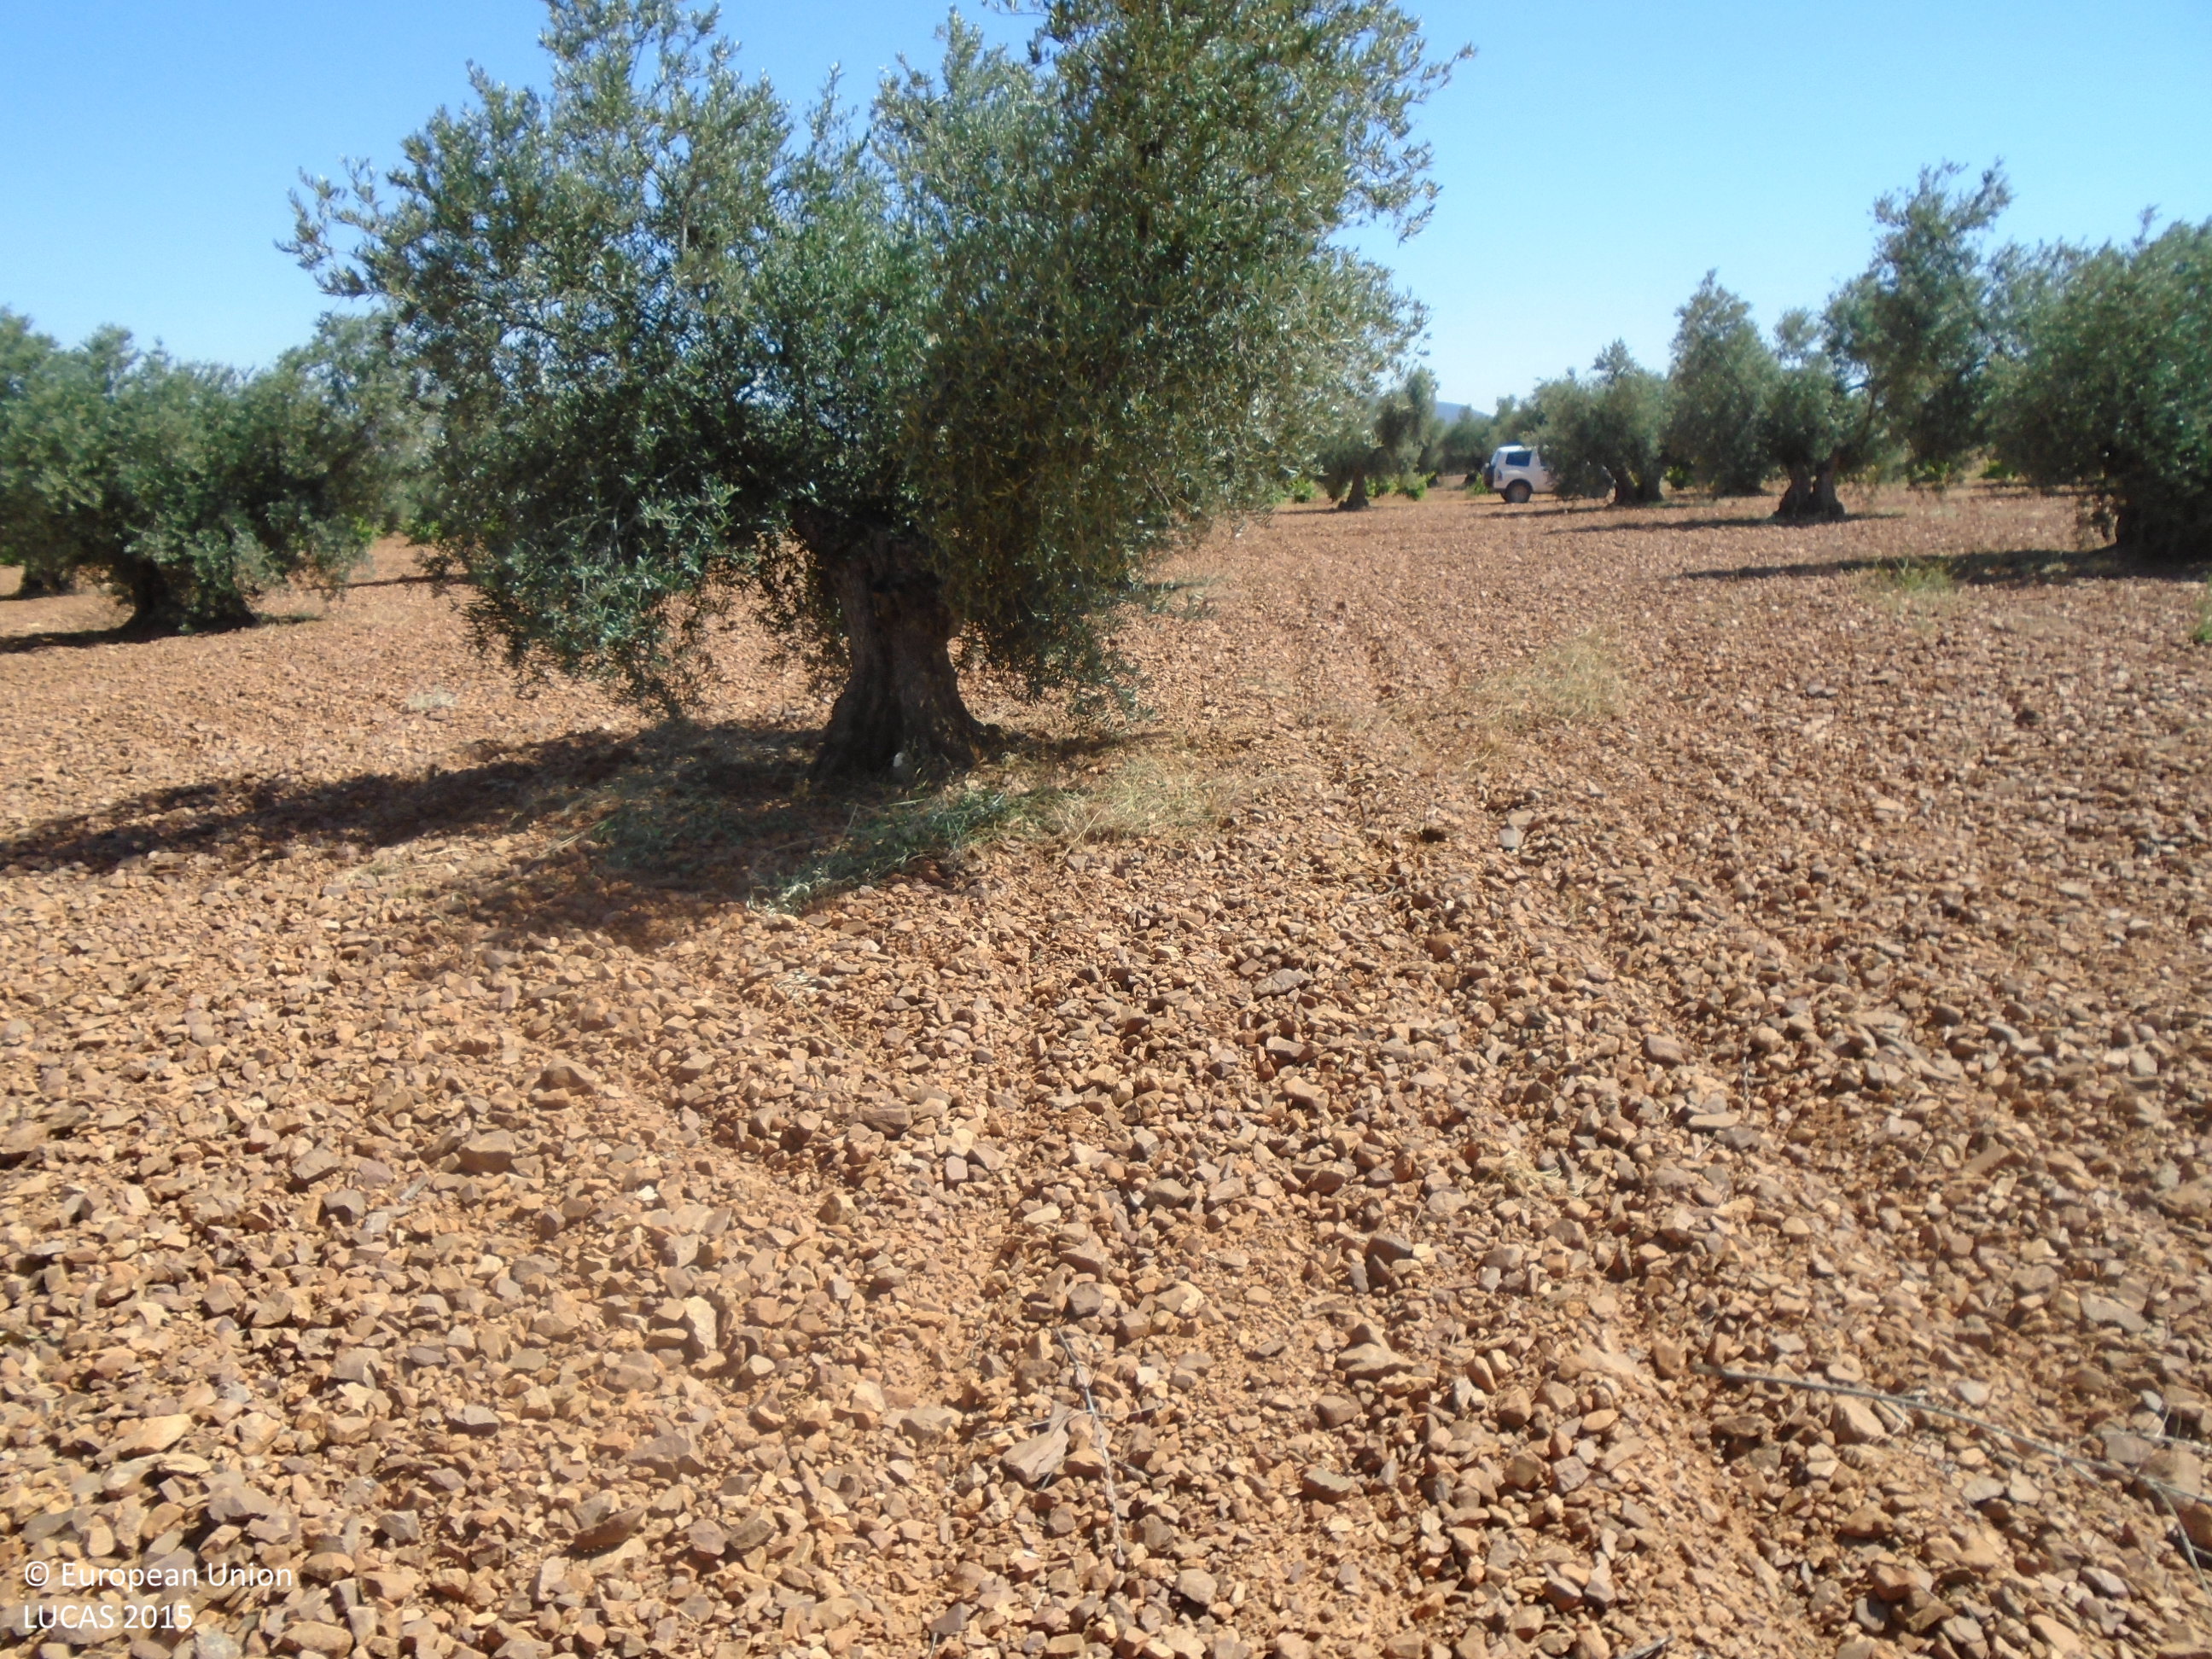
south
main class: Cropland
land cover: Olive groves
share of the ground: 10 - 25 %
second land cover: Other bare soil
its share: > 75 %
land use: Agriculture (excluding fallow land and kitchen gardens)
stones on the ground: > 50 %
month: June
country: ES
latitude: 39.4541
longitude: -3.6557
